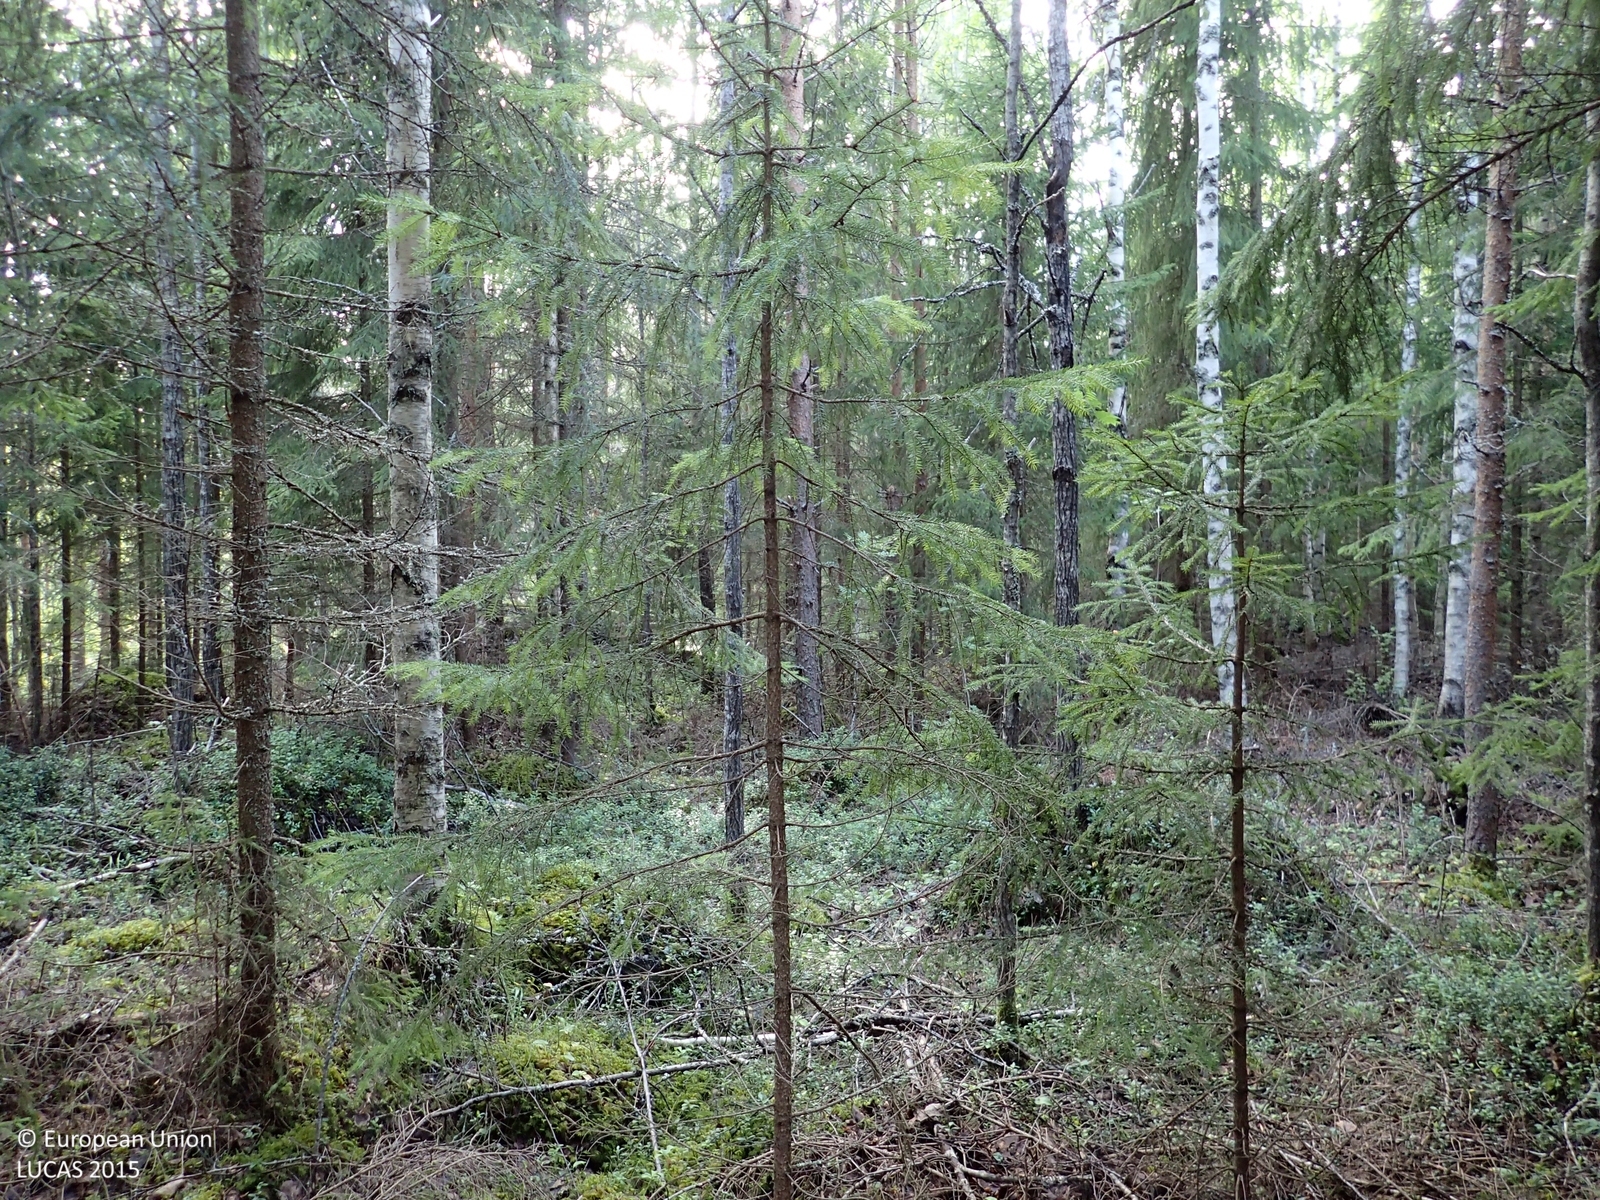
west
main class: Woodland
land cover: Spruce dominated mixed woodland
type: boreal forest
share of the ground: > 75 %
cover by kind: coniferous forest trees 60 %, broadleaved forest trees 20 %, shrubs 15 %, lichens and mosses 5 %
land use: Forestry
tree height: > 5 m
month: July
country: FI
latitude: 62.9554
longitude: 21.9719
